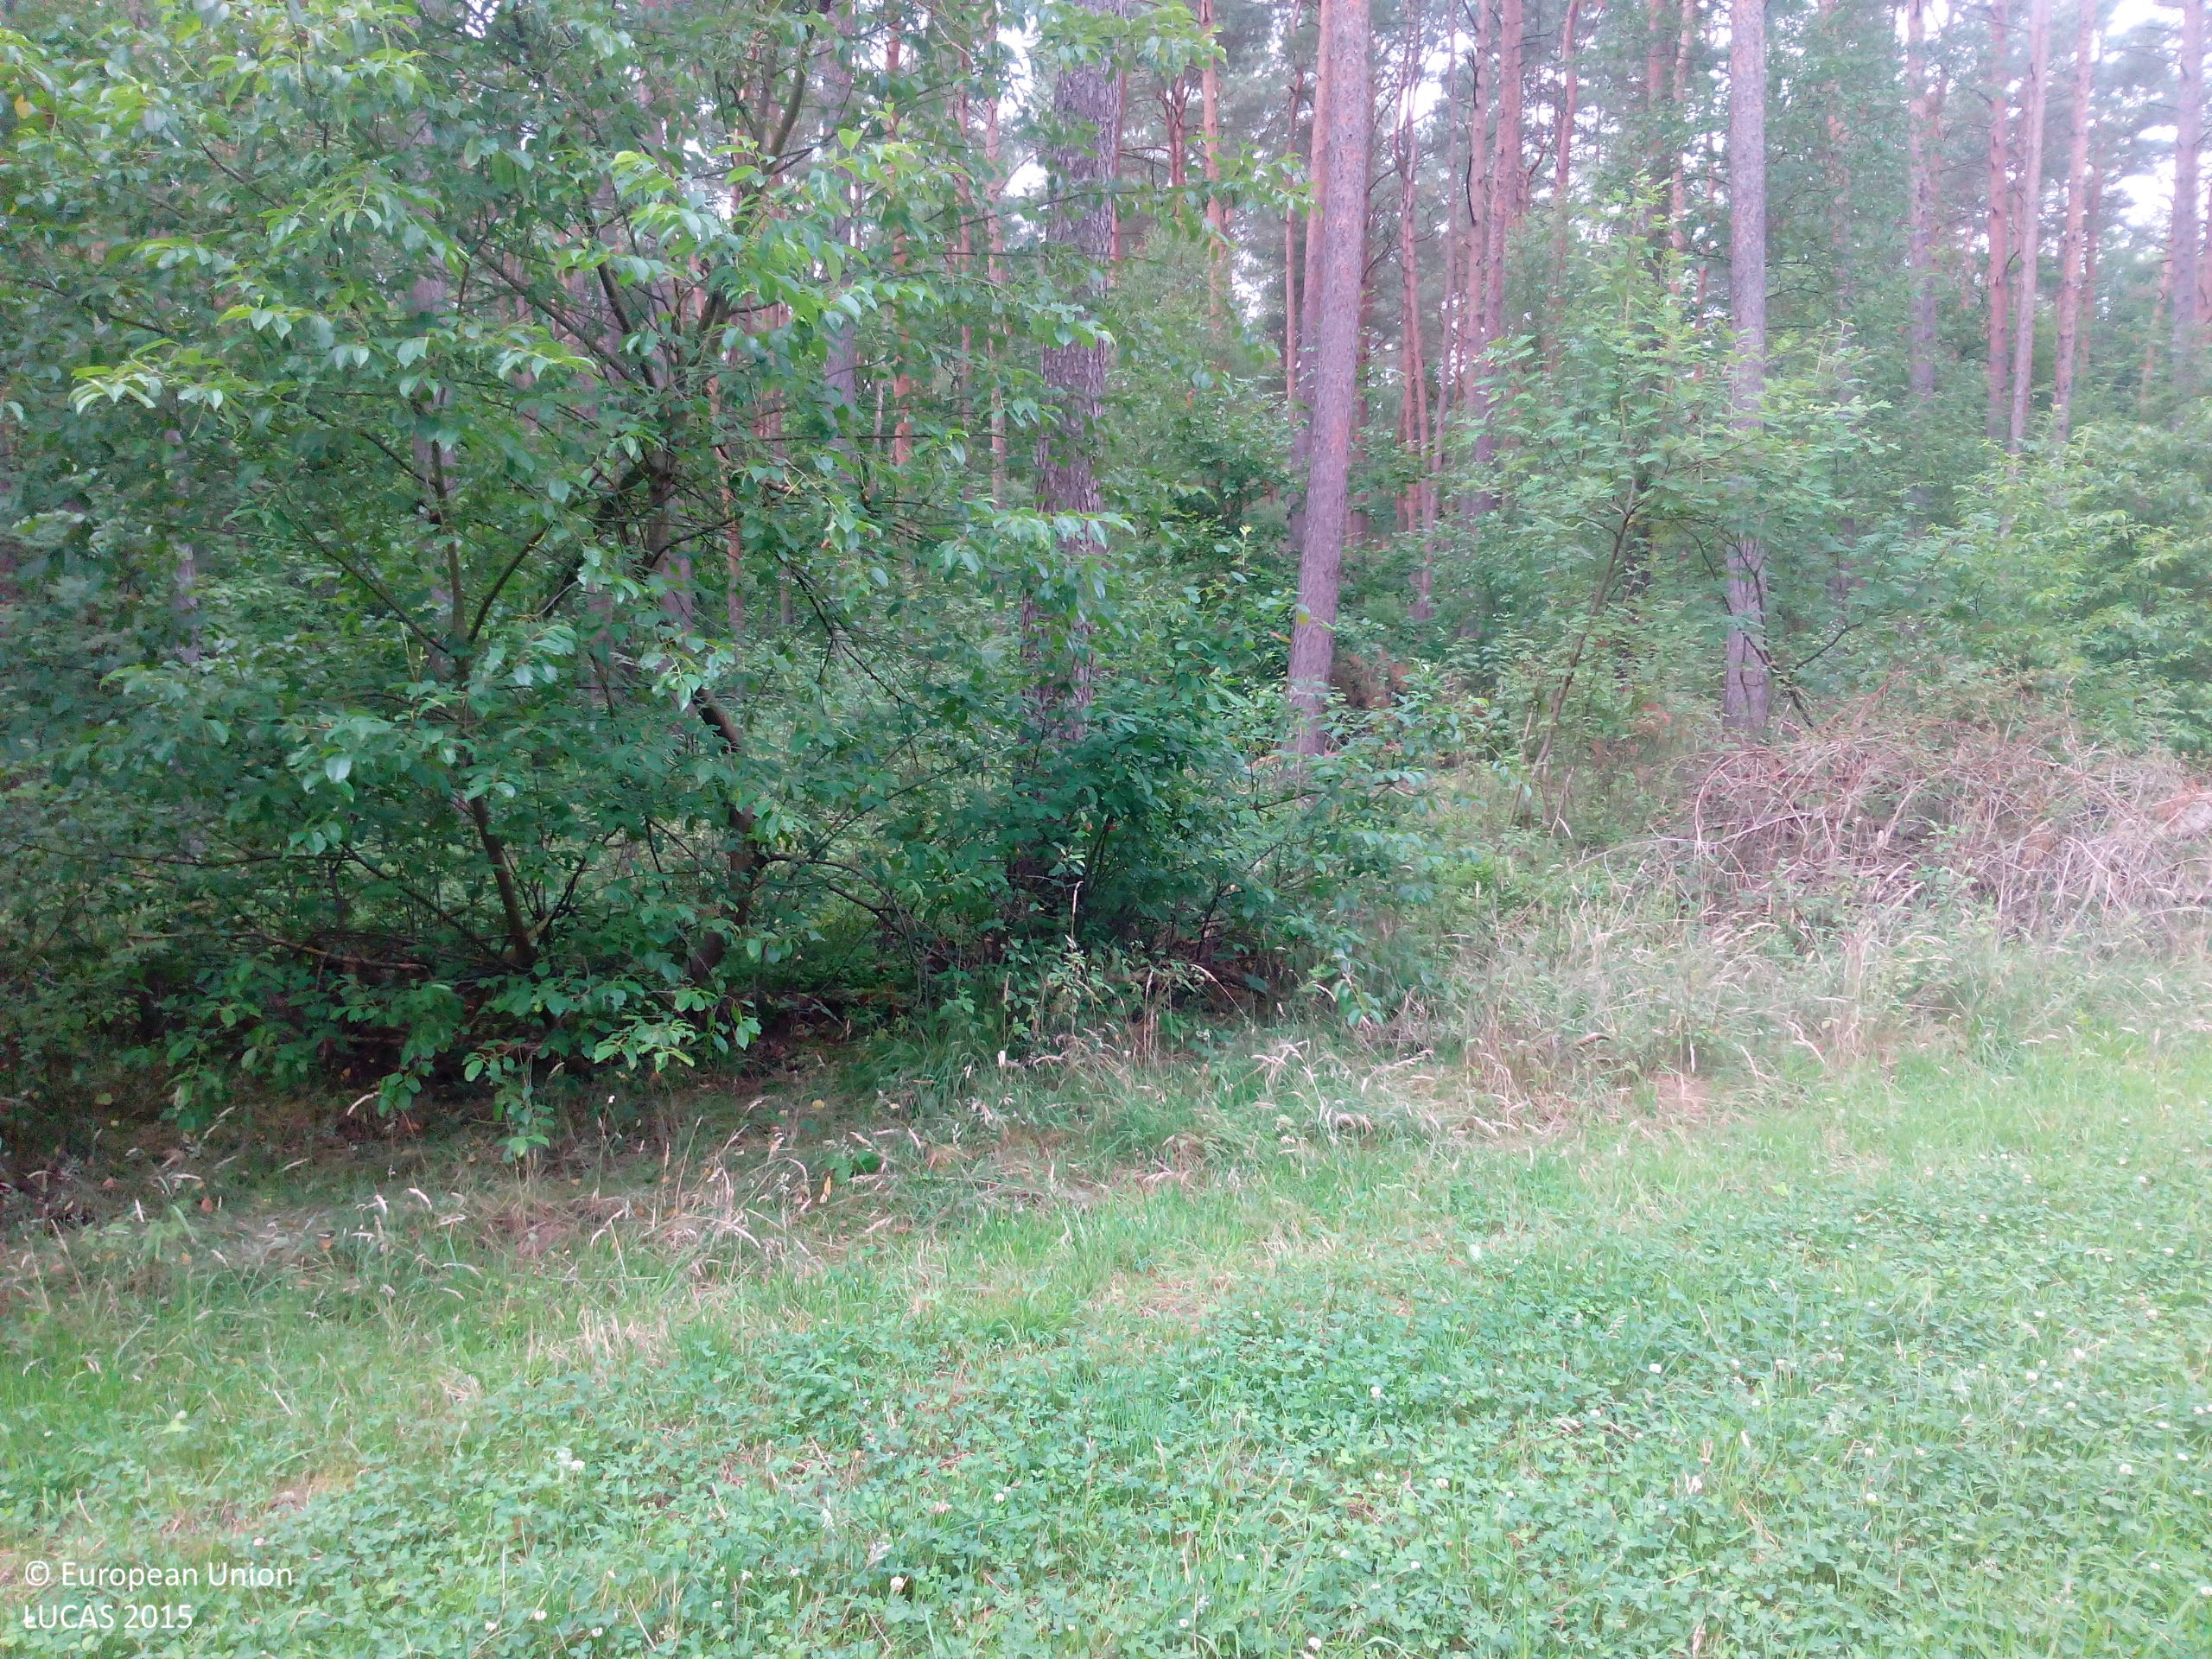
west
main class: Grassland
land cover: Grassland without tree/shrub cover
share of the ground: > 75 %
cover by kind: herbaceous plants 90 %, unconsolidated bare surface 10 %
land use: Road transport
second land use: Forestry
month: July
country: DE
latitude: 52.8444
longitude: 10.3117
